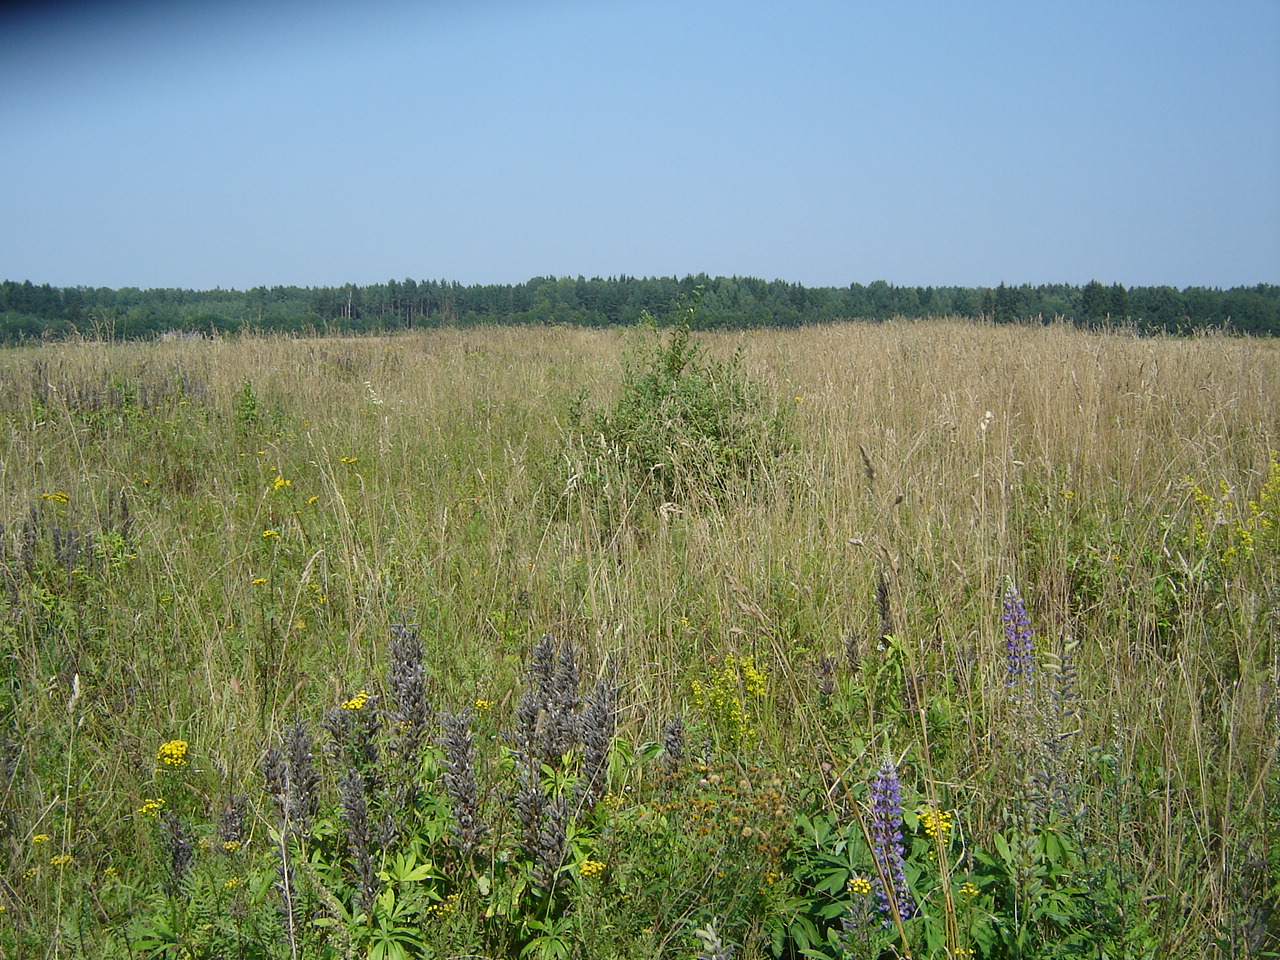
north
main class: Grassland
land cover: Spontaneously vegetated surfaces
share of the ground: > 75 %
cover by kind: herbaceous plants 100 %
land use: Fallow land
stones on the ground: < 10 %
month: August
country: LT
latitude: 55.0177
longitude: 25.0508
